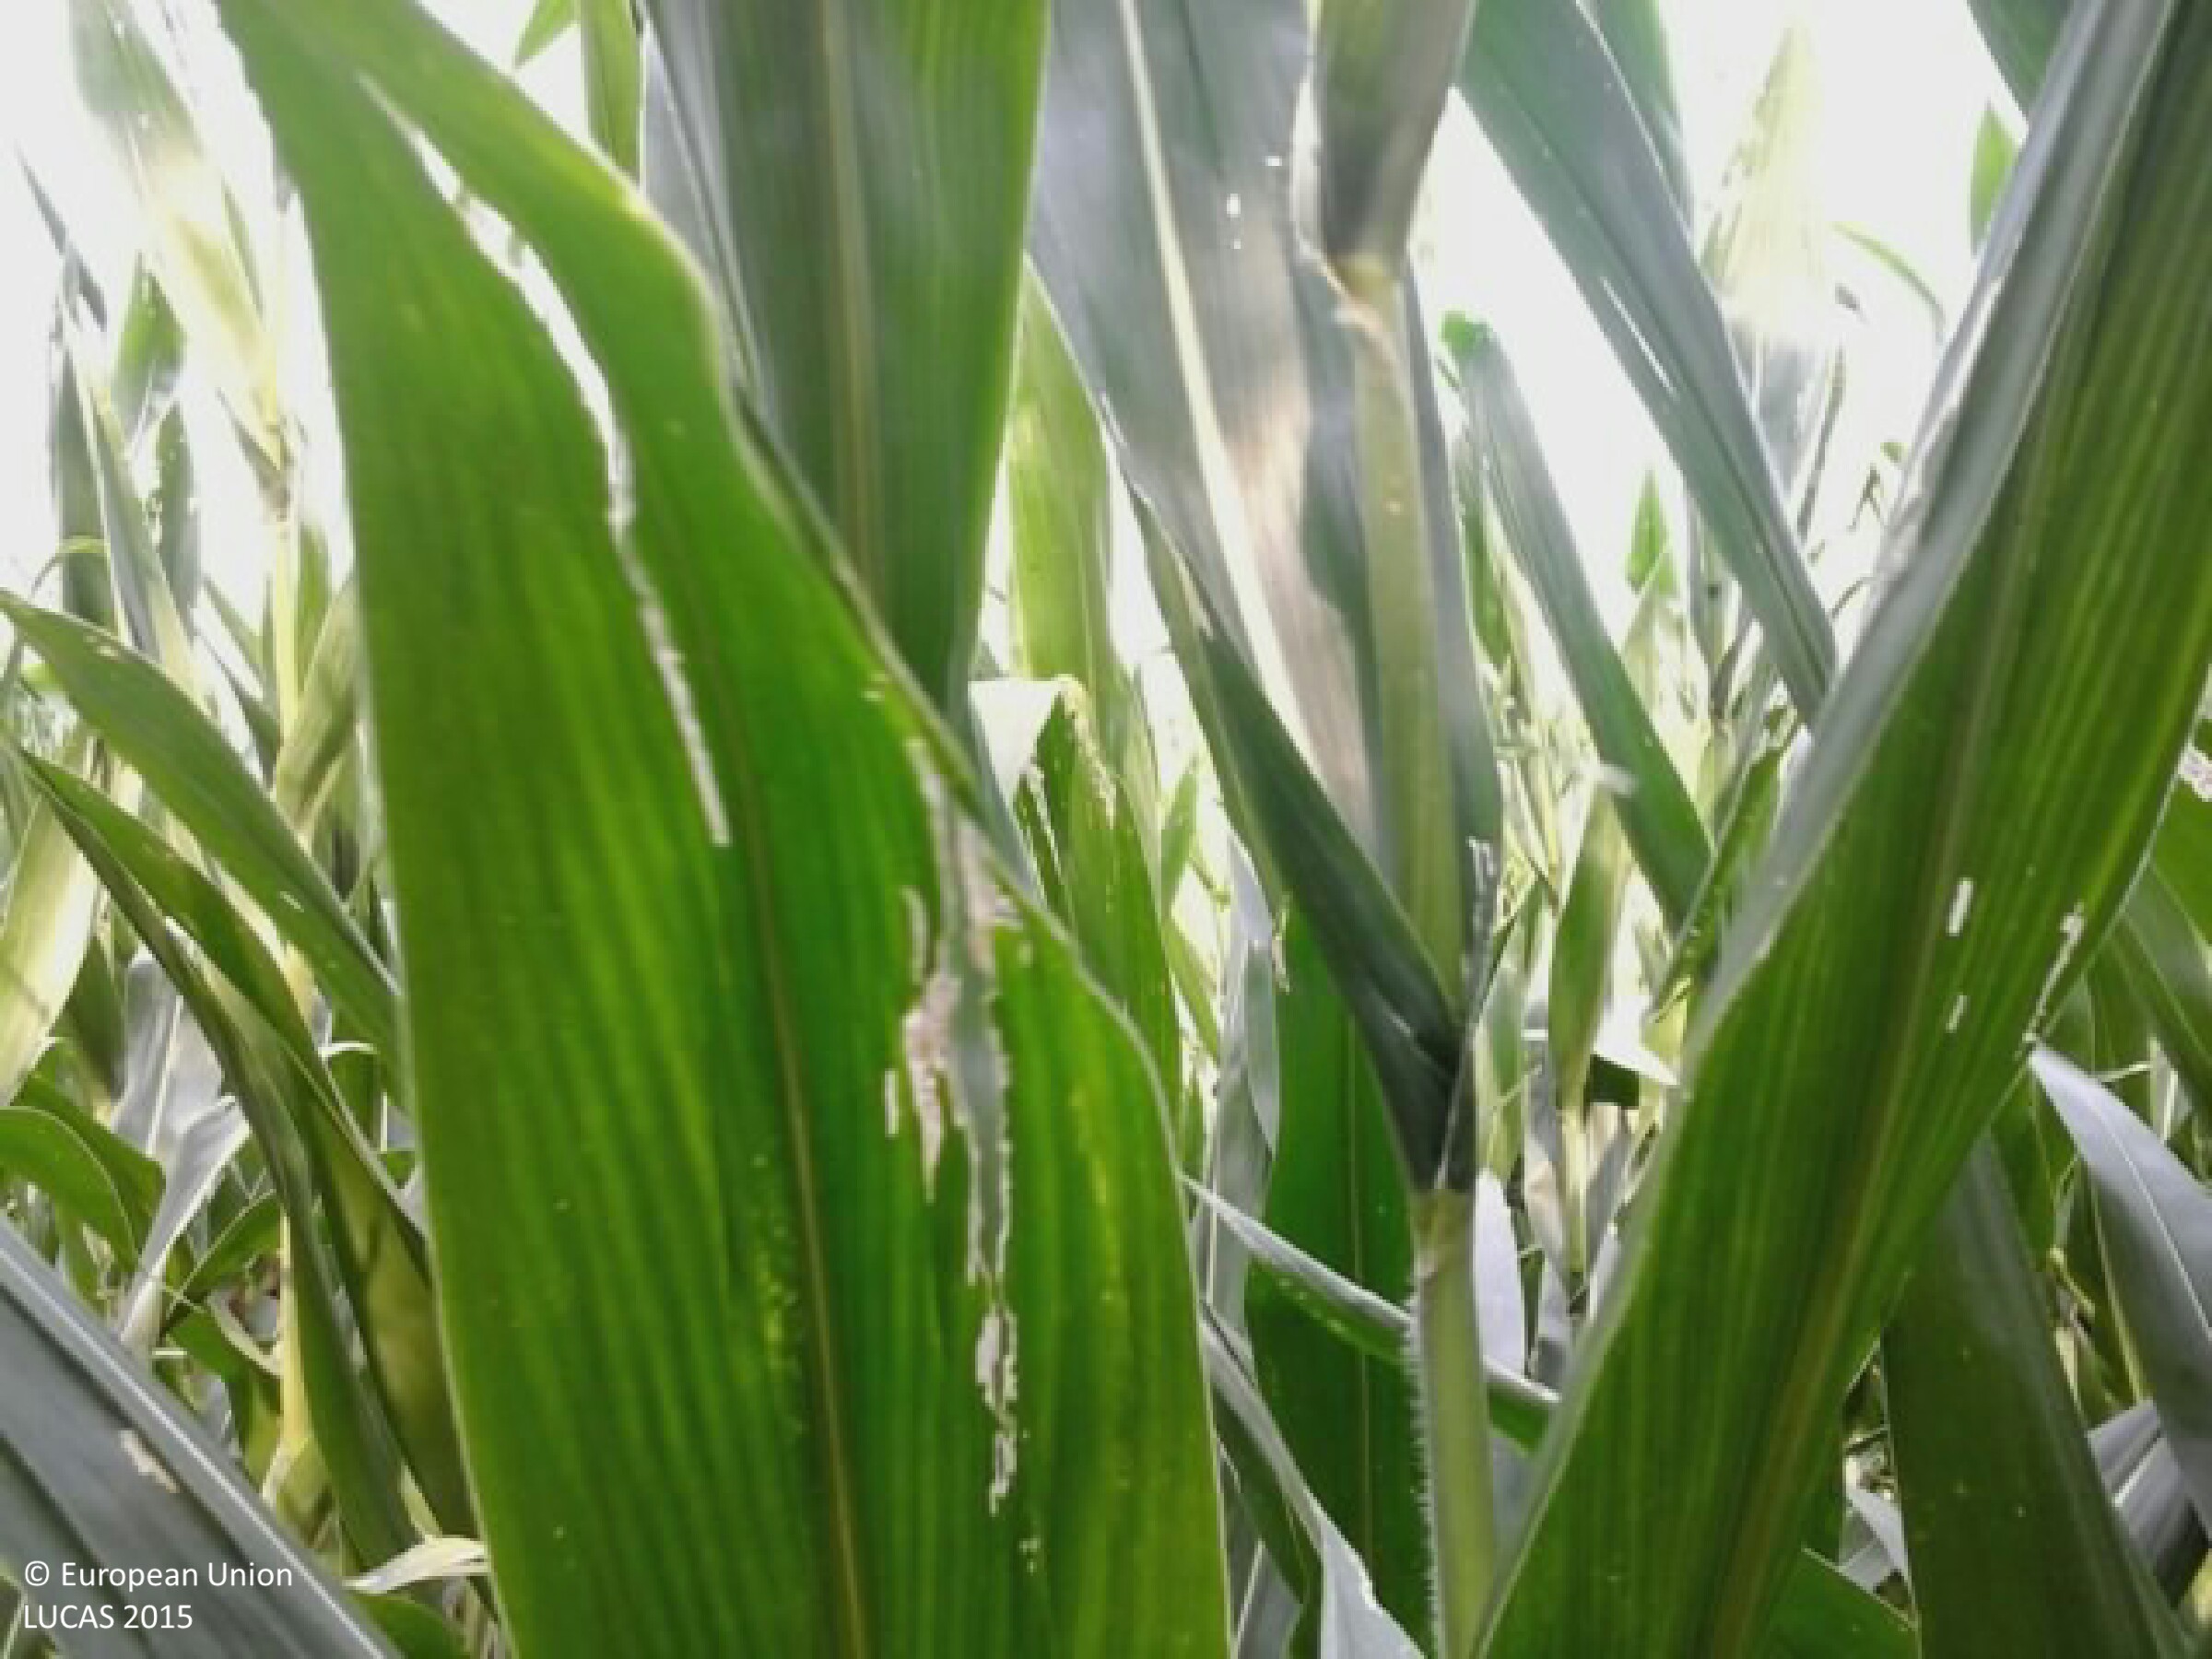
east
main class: Cropland
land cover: Maize
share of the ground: > 75 %
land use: Agriculture (excluding fallow land and kitchen gardens)
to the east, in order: Maize
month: August
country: HU
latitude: 46.4682
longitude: 17.9901
